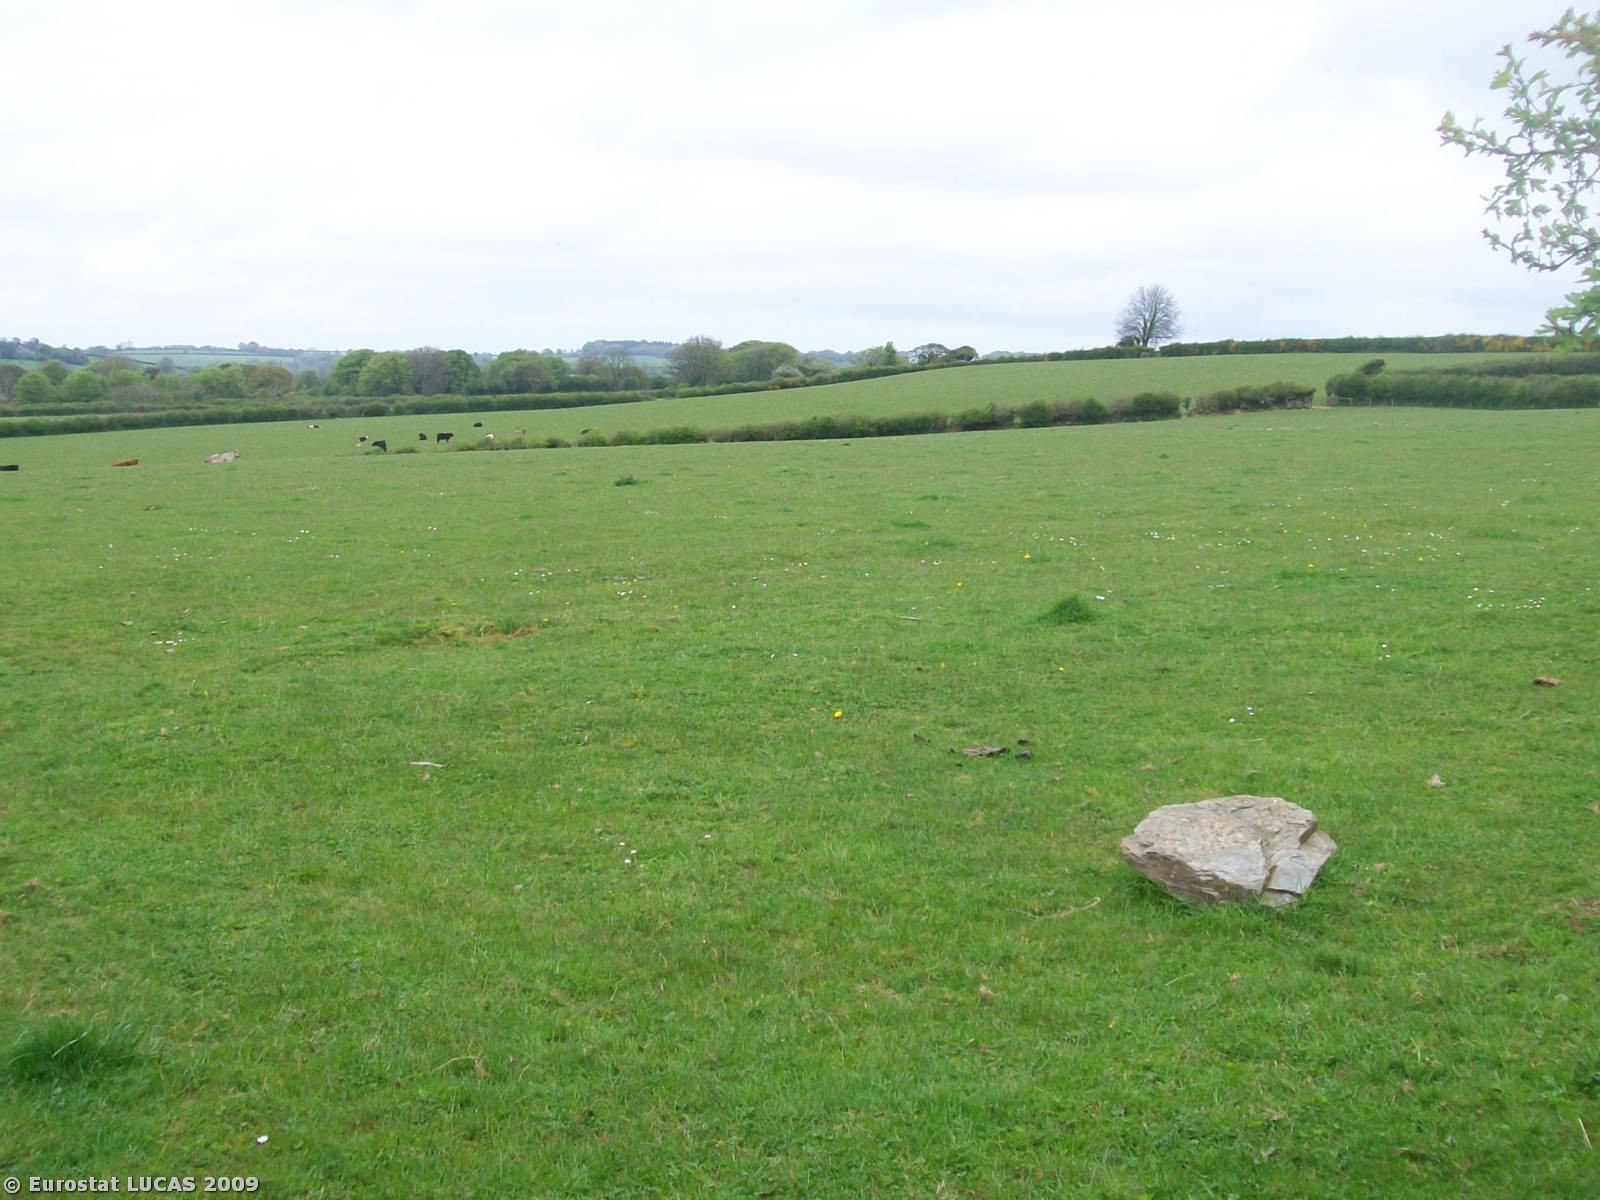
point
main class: Grassland
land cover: Grassland without tree/shrub cover
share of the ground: > 75 %
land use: Agriculture (excluding fallow land and kitchen gardens)
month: May
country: GB
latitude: 50.5117
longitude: -4.3582
